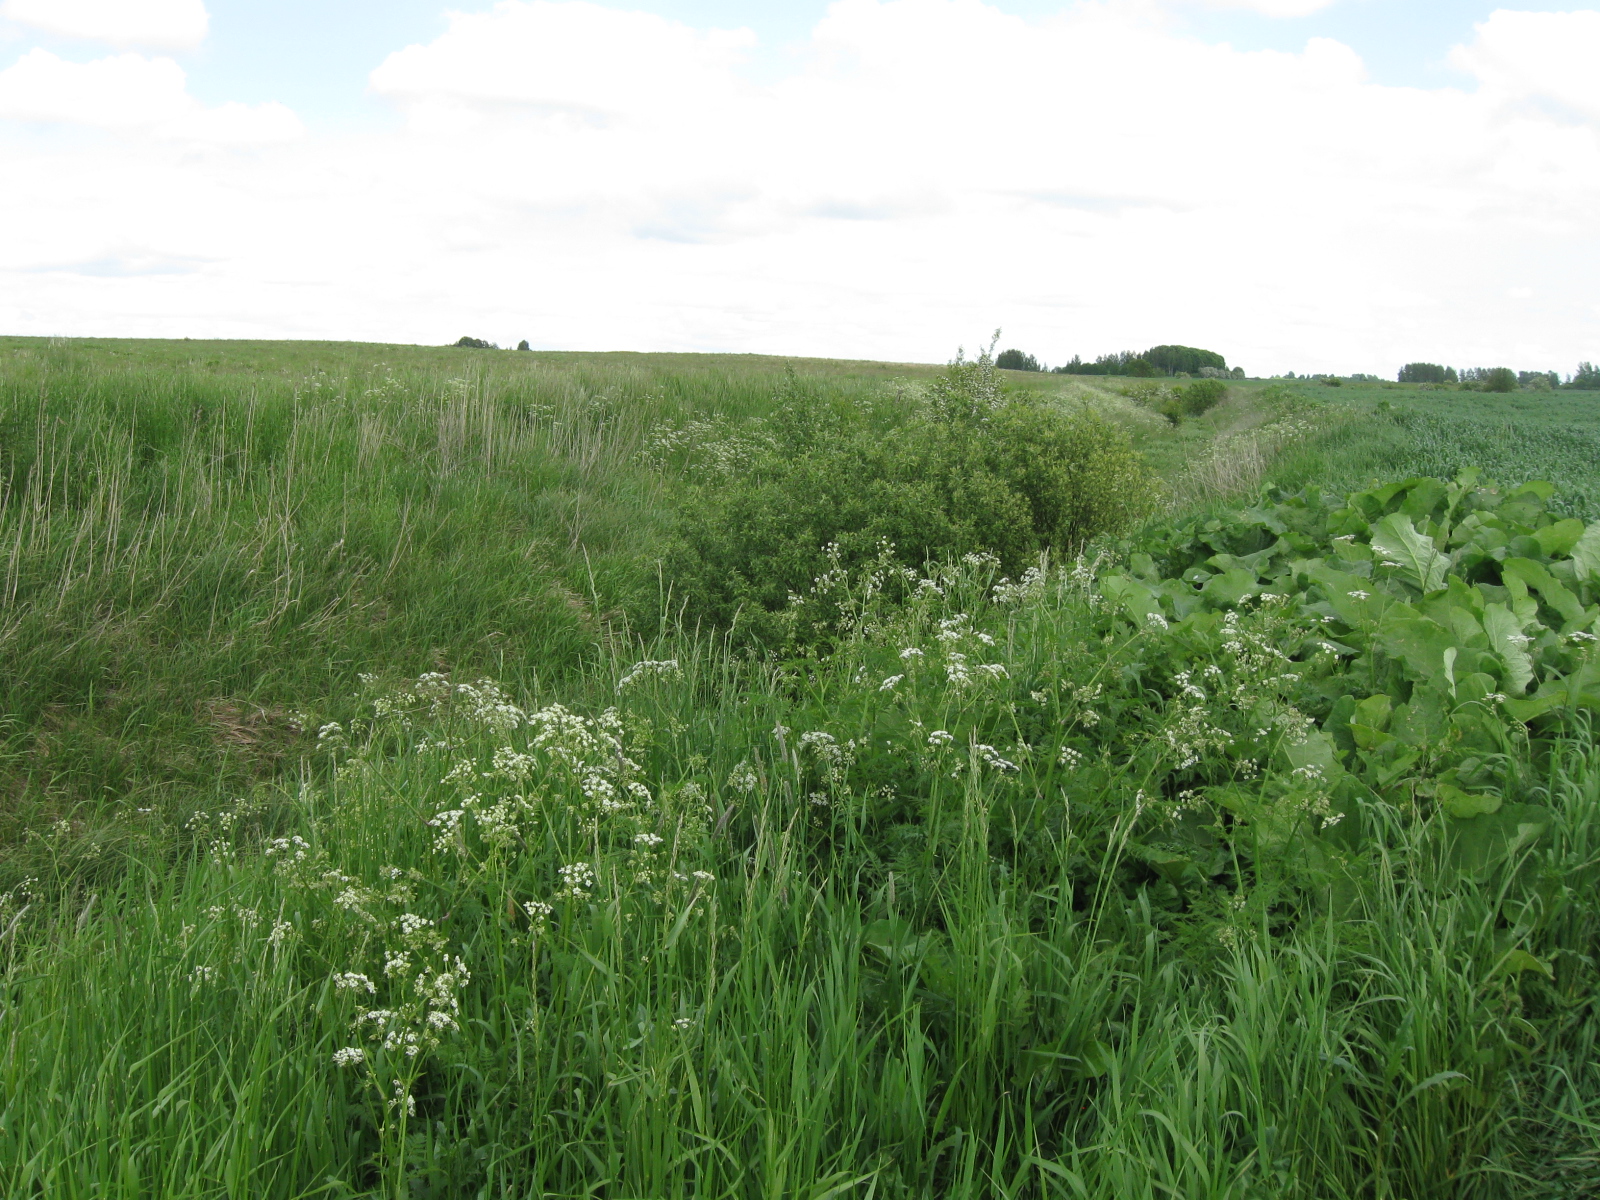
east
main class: Grassland
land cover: Grassland without tree/shrub cover
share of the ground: > 75 %
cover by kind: herbaceous plants 100 %
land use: Agriculture (excluding fallow land and kitchen gardens)
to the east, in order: Grassland without tree/shrub cover; Grassland with sparse tree/shrub cover; Ditches and canals; Grassland with sparse tree/shrub cover; Grassland without tree/shrub cover
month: May
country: LT
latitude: 54.6894
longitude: 22.7734
